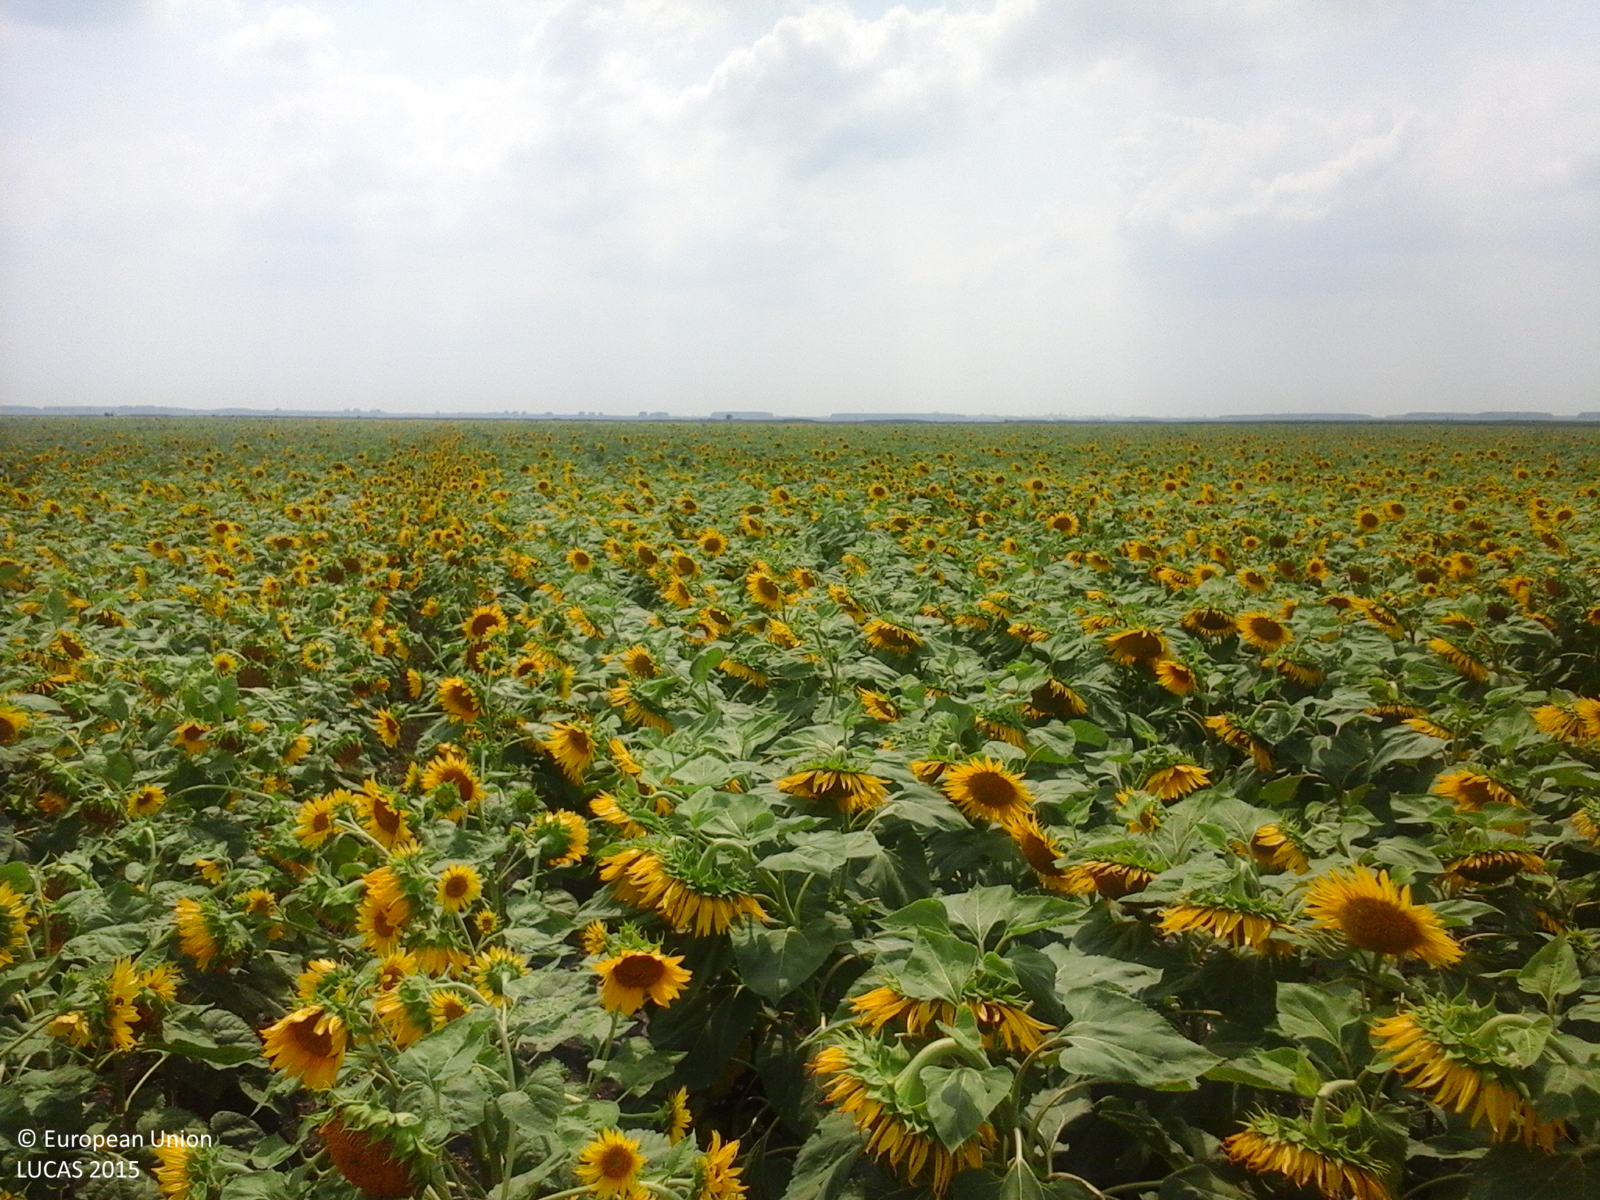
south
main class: Cropland
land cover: Sunflower
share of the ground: > 75 %
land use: Agriculture (excluding fallow land and kitchen gardens)
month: July
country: RO
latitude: 45.3127
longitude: 28.0648
